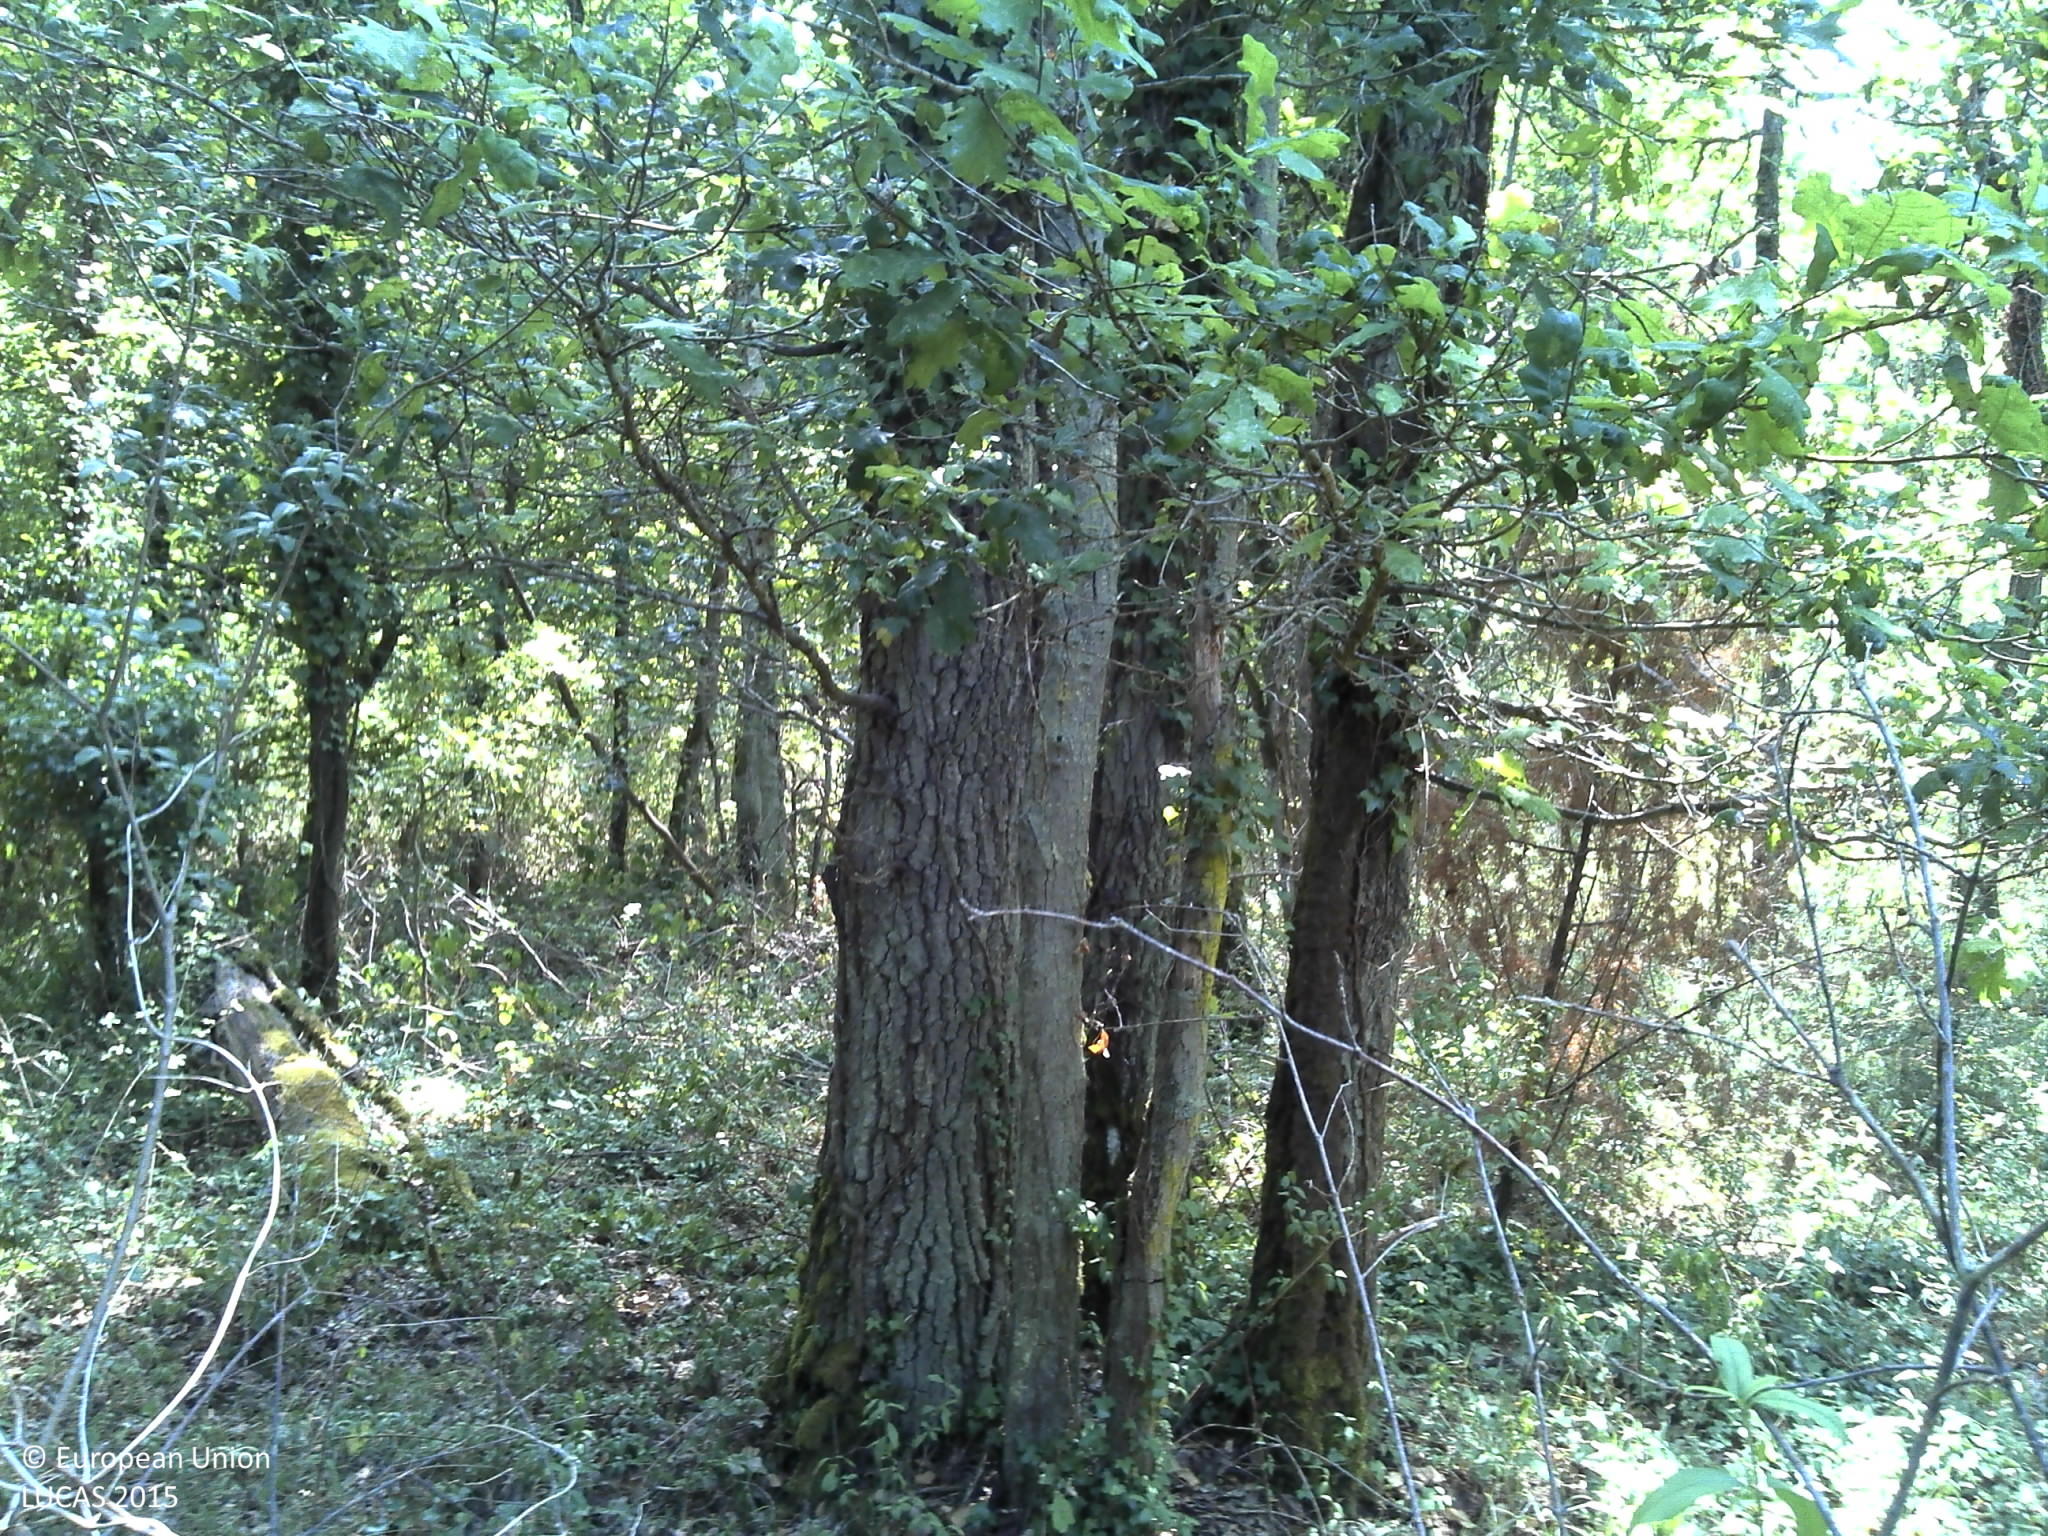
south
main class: Woodland
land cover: Broadleaved woodland
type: acidophilous oak and oak-birch forest
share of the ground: 50 - 75 %
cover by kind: broadleaved forest trees 90 %
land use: Forestry
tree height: > 5 m
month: July
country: FR
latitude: 48.4153
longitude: 2.4364
